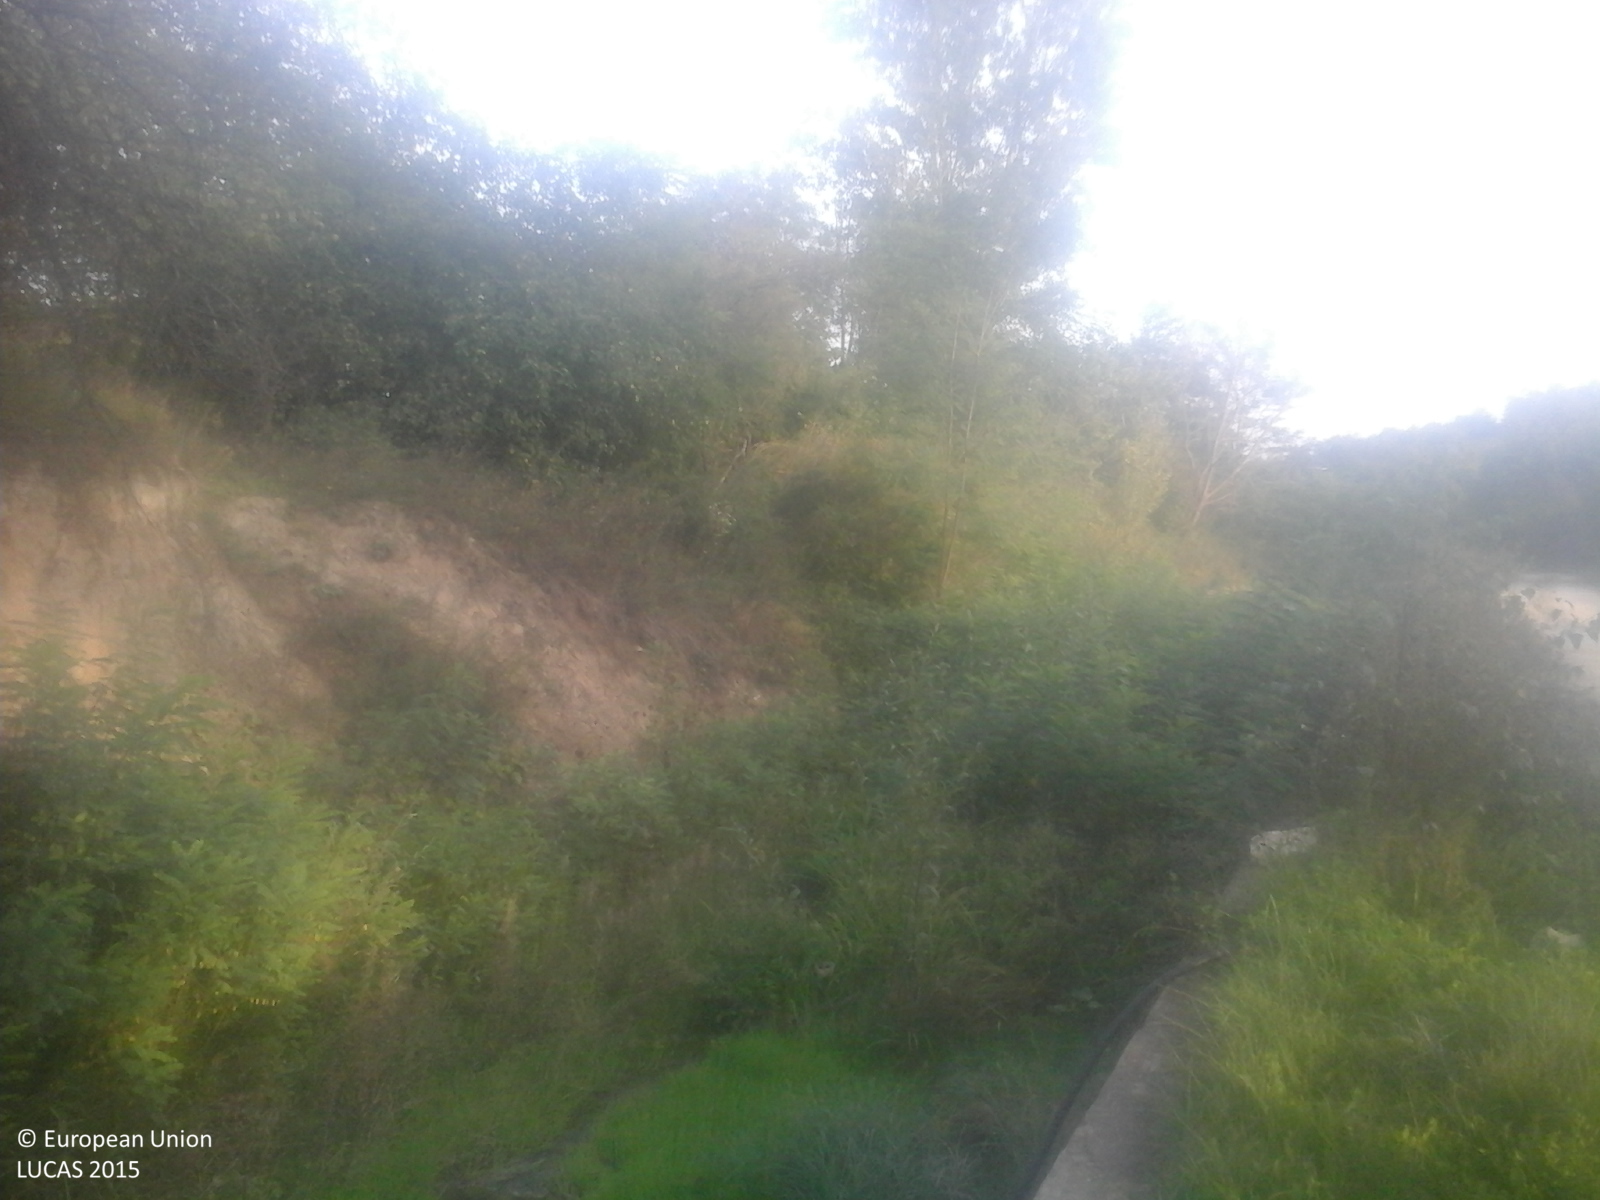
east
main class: Cropland
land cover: Apple fruit
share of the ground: 25 - 50 %
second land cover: Grassland without tree/shrub cover
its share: > 75 %
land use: Agriculture (excluding fallow land and kitchen gardens)
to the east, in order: Apple fruit; Grassland without tree/shrub cover; Permanent crops (only in case pi); Broadleaved woodland
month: September
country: RO
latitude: 47.0745
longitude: 23.0887
